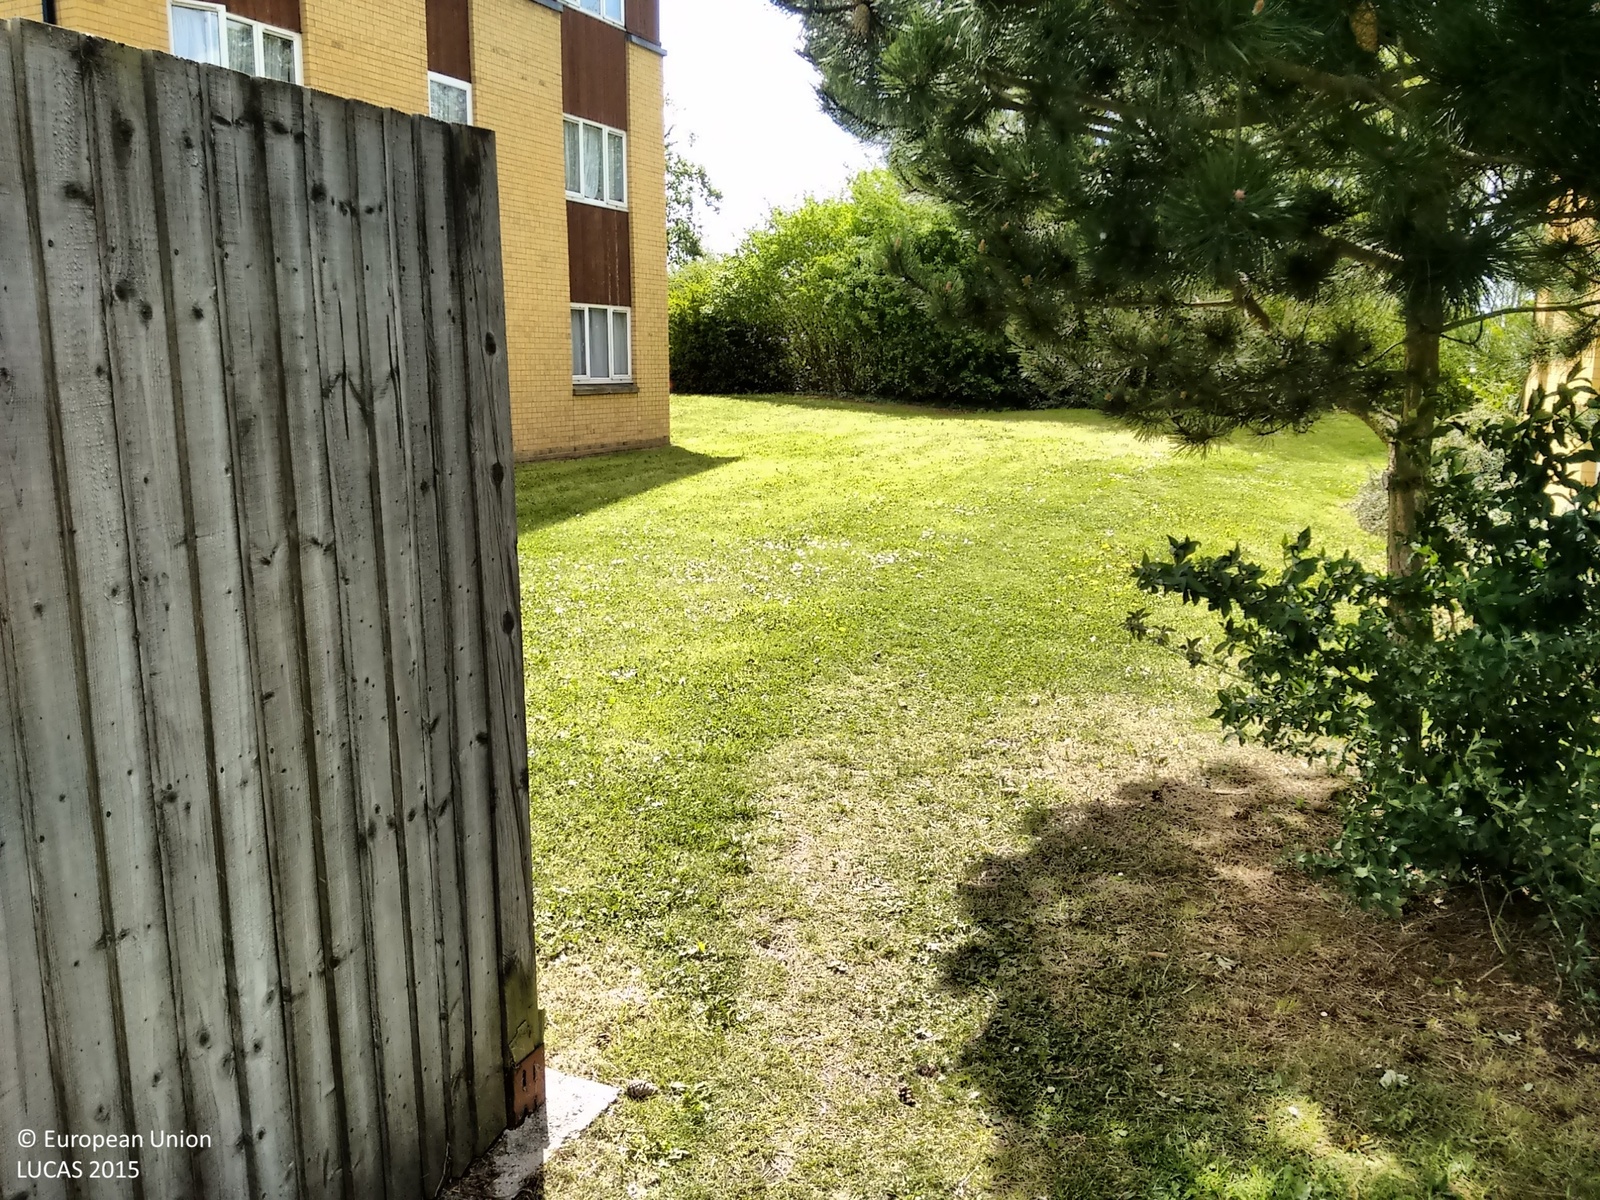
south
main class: Grassland
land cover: Grassland with sparse tree/shrub cover
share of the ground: > 75 %
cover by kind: herbaceous plants 95 %, coniferous forest trees 5 %
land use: Residential
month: May
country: GB
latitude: 51.4327
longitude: 0.2604
